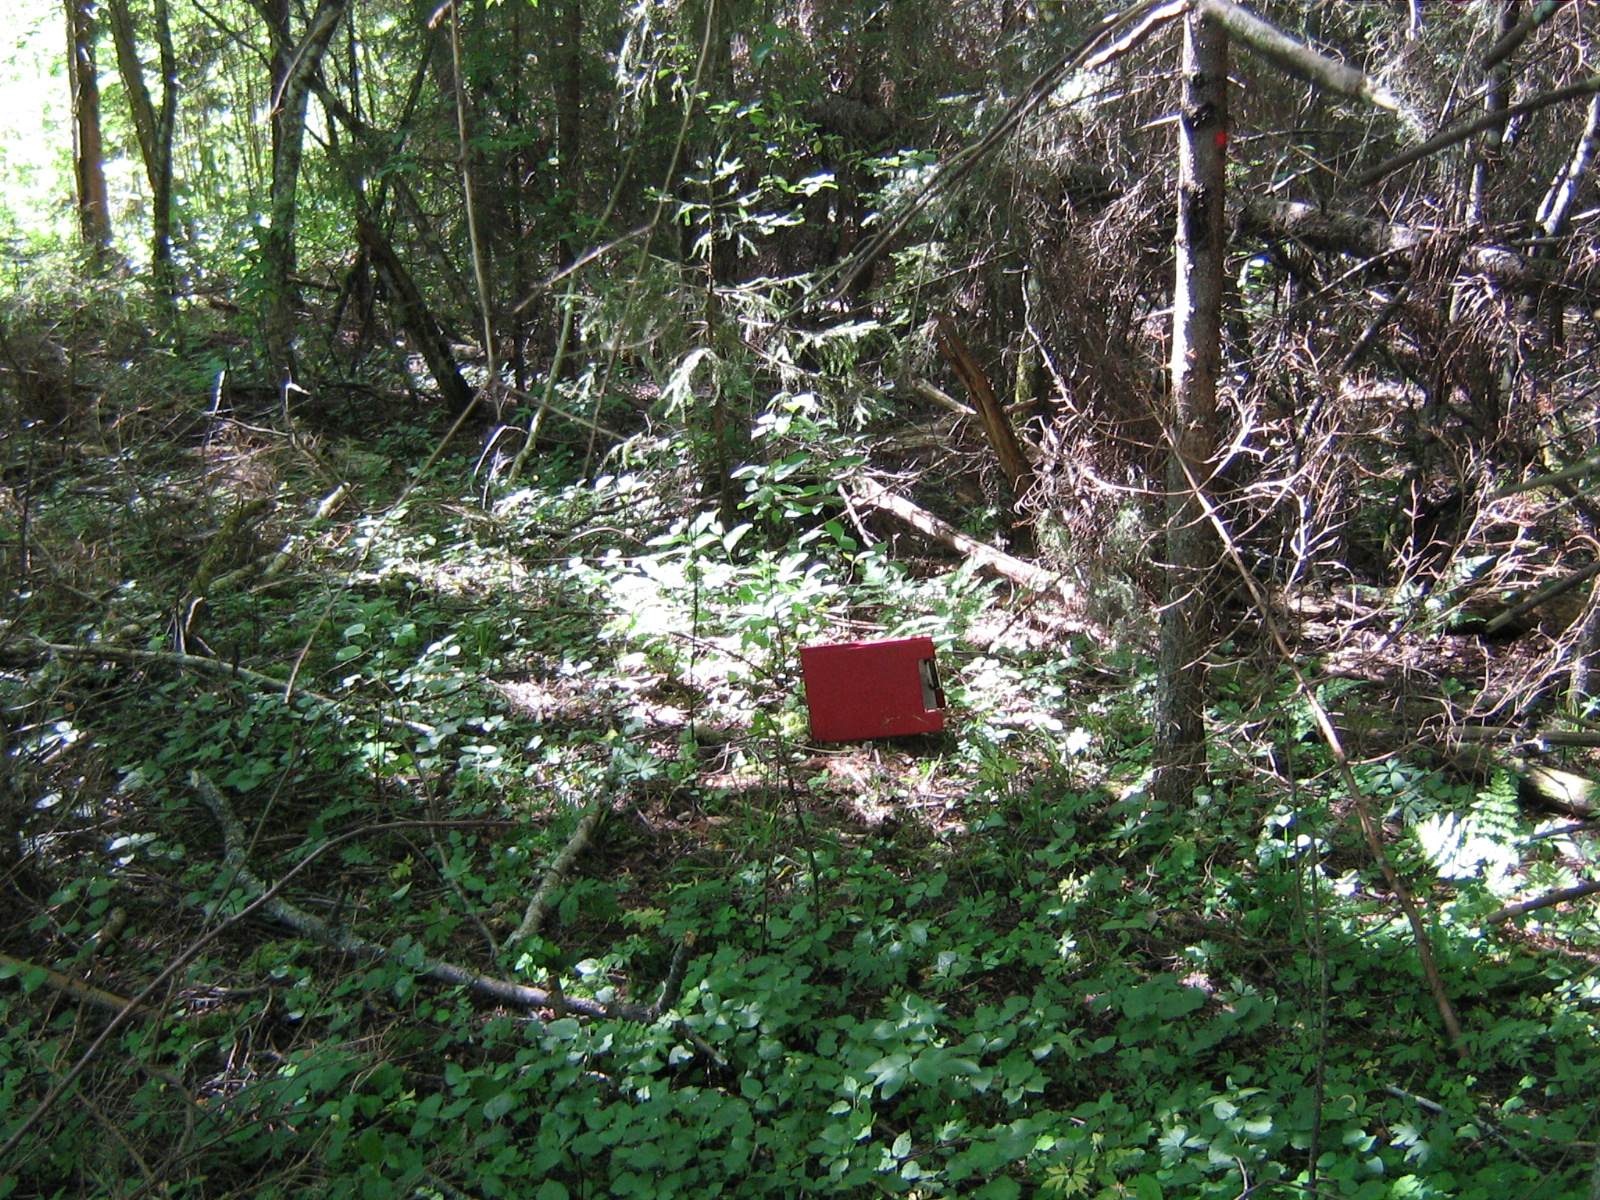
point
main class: Woodland
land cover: Spruce dominated mixed woodland
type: hemiboreal forest and nemoral coniferous forest and mixed broadleaved-coniferous forest
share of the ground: > 75 %
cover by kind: coniferous forest trees 70 %, broadleaved forest trees 30 %
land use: Forestry
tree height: > 5 m
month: June
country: LV
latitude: 56.9012
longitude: 25.4020
